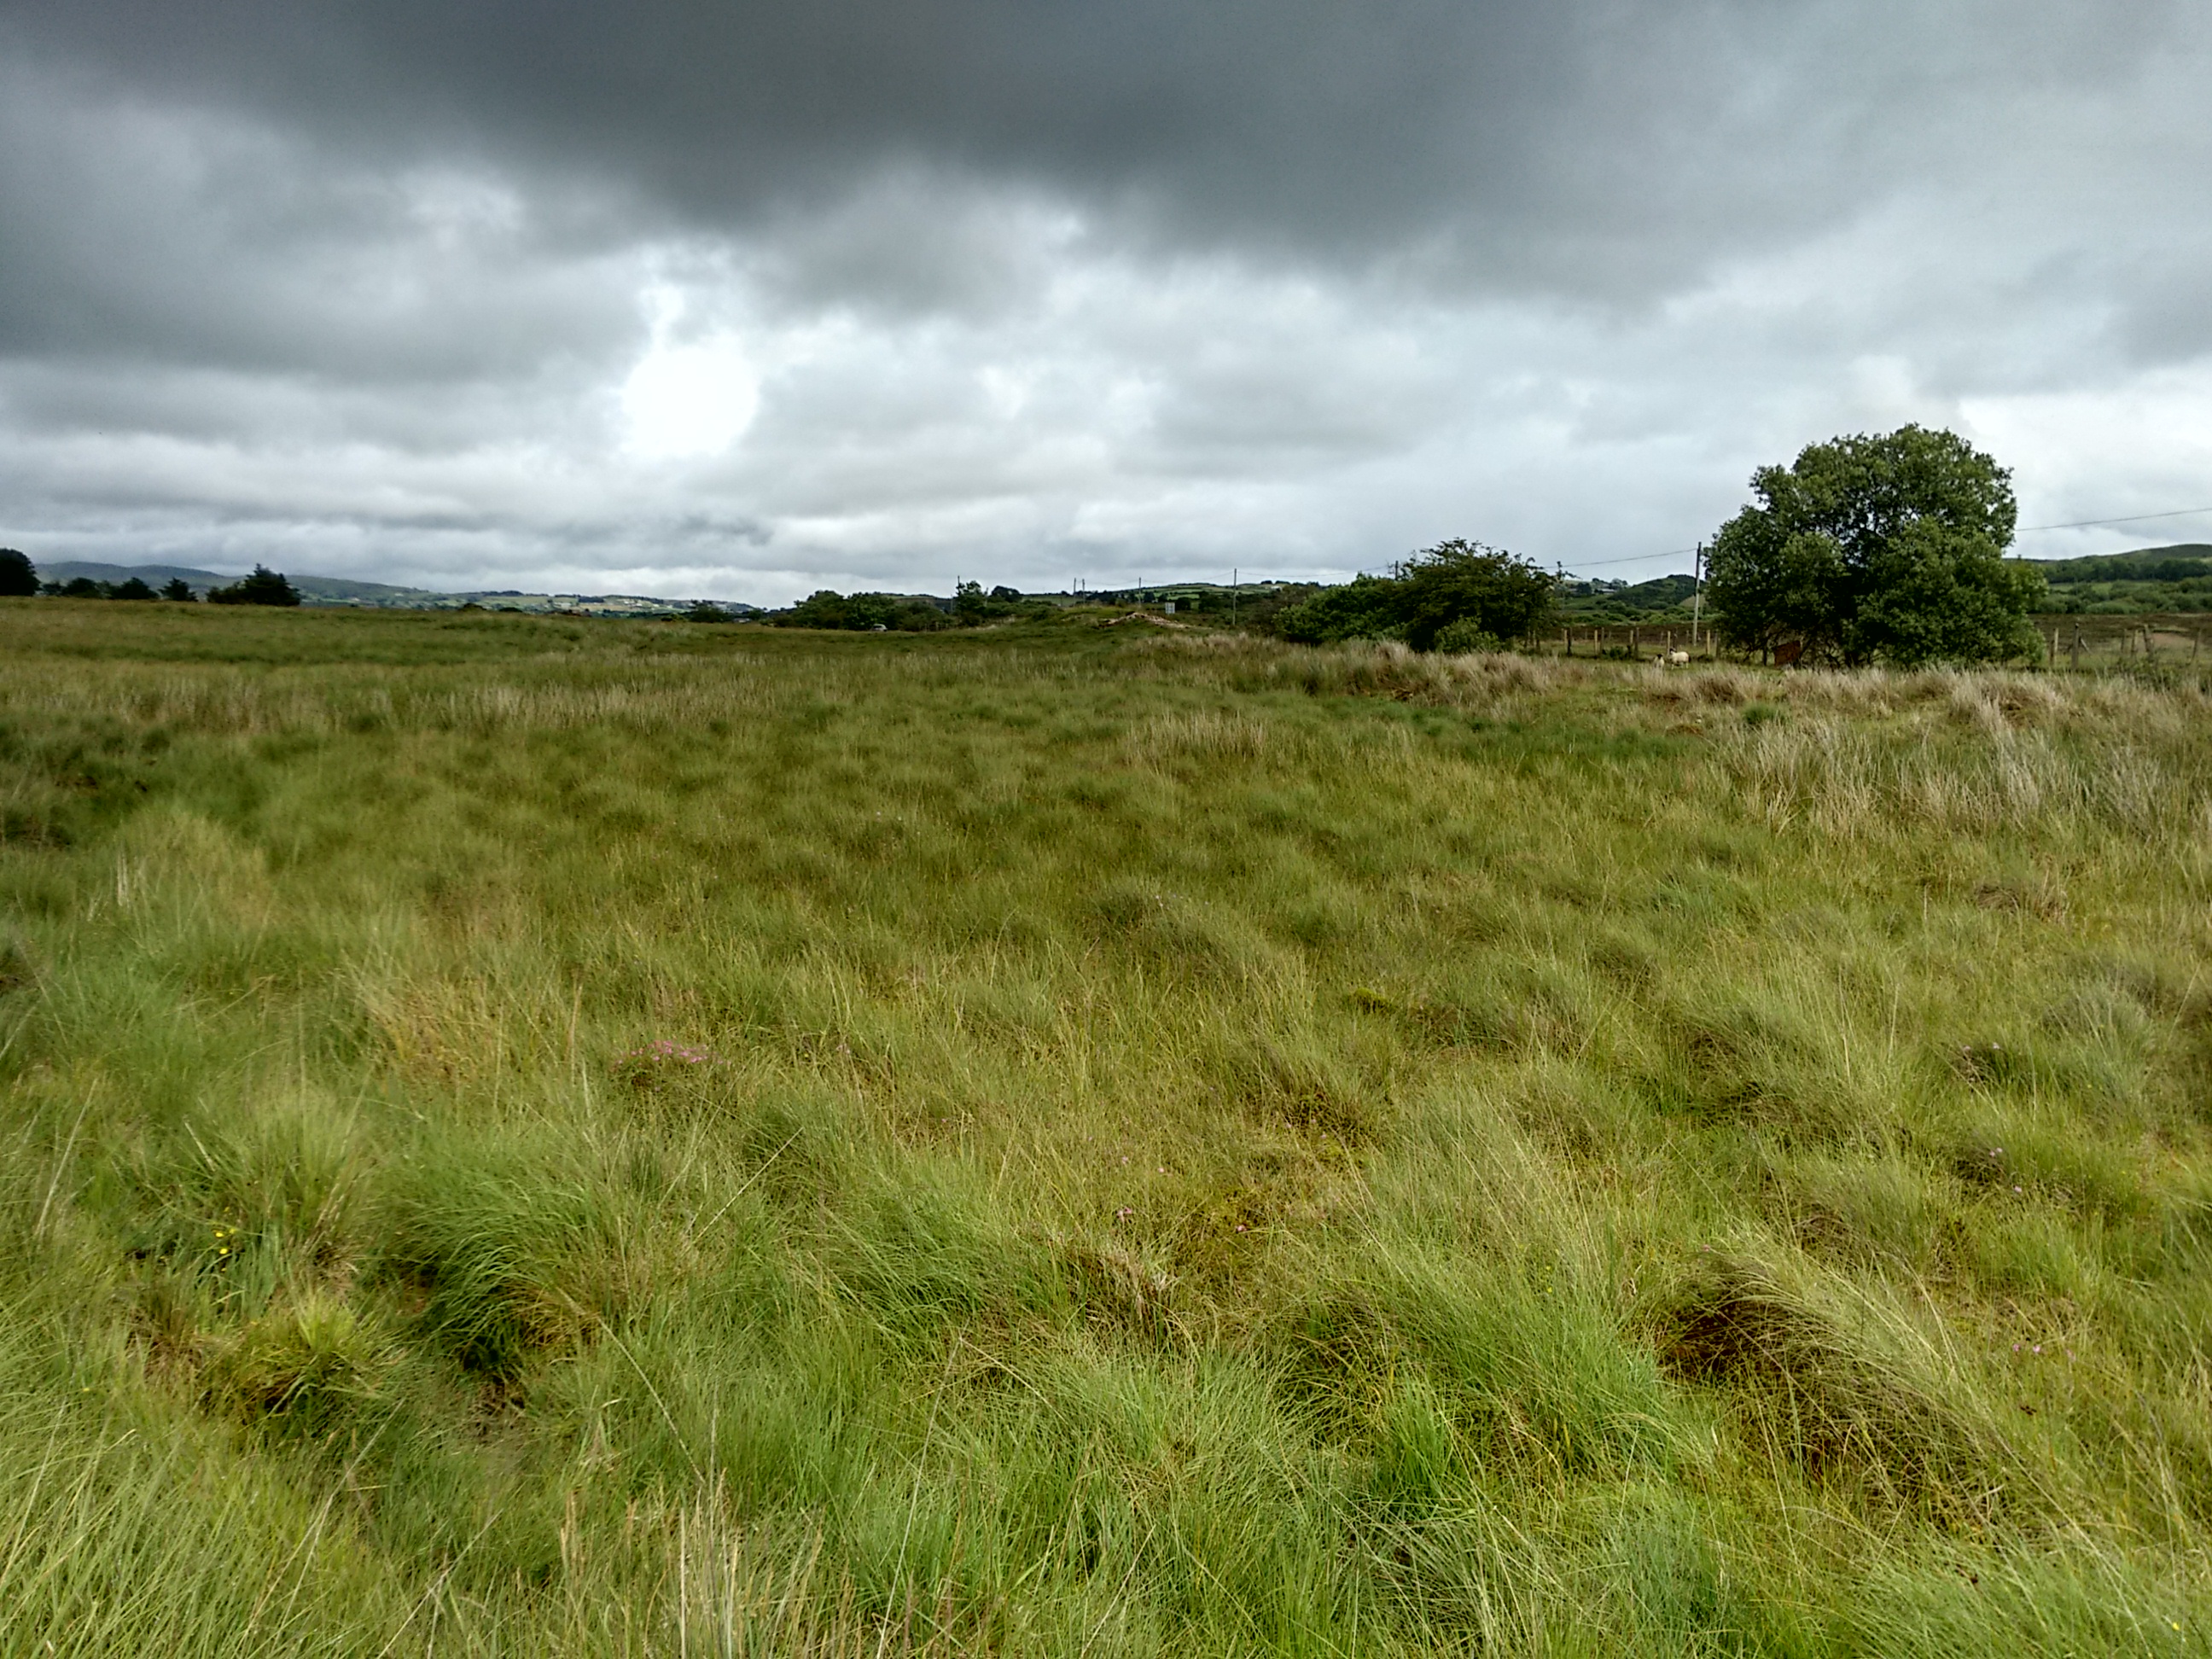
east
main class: Grassland
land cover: Grassland without tree/shrub cover
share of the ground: > 75 %
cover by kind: herbaceous plants 100 %
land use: Agriculture (excluding fallow land and kitchen gardens)
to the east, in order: Grassland without tree/shrub cover; Ditches and canals; Grassland without tree/shrub cover; Ditches and canals; Grassland without tree/shrub cover; Tracks; Grassland without tree/shrub cover; Fences; Grass margins; Fences; Grass margins; Paved roads, cycling and walking lanes; Grass margins; Tracks; Fences; Electric lines; Grassland without tree/shrub cover; Fences; Rivers and streams; Grassland without tree/shrub cover
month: July
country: GB
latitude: 54.6553
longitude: -6.9875
